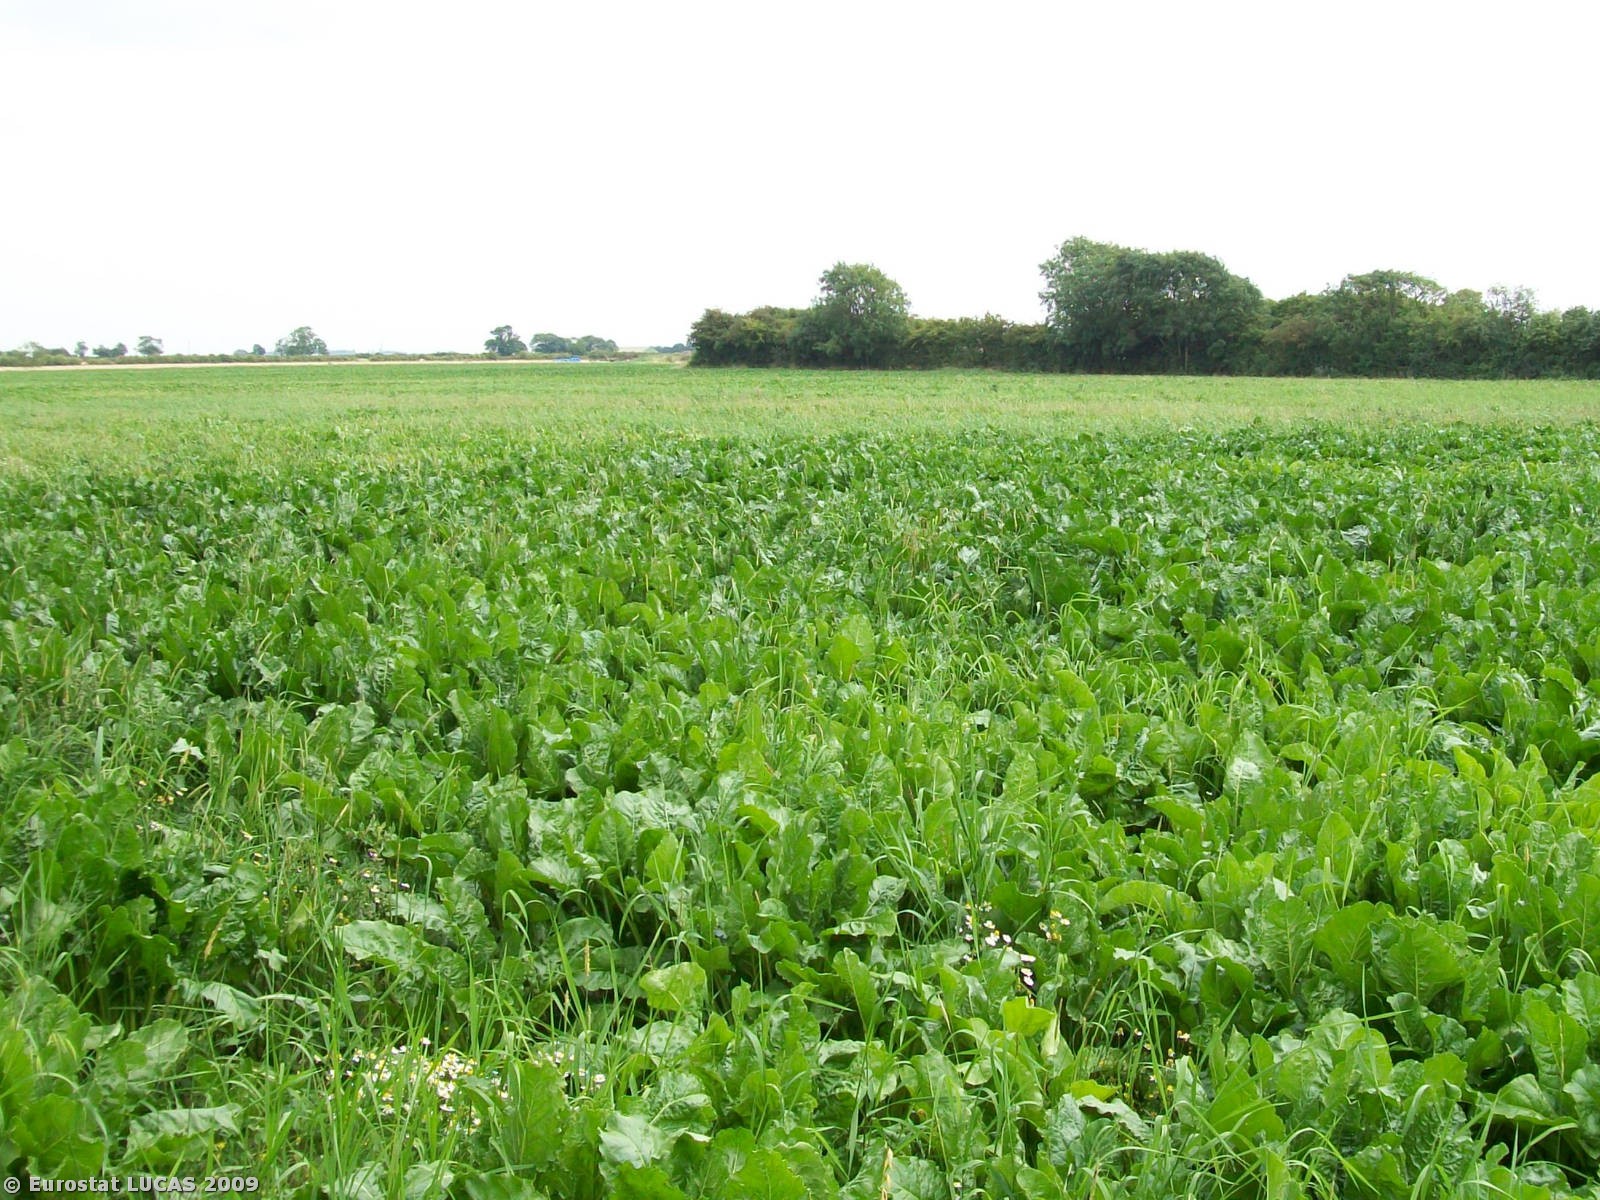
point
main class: Cropland
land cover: Sugar beet
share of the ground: > 75 %
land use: Agriculture (excluding fallow land and kitchen gardens)
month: August
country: GB
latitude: 53.6854
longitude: -0.3161
